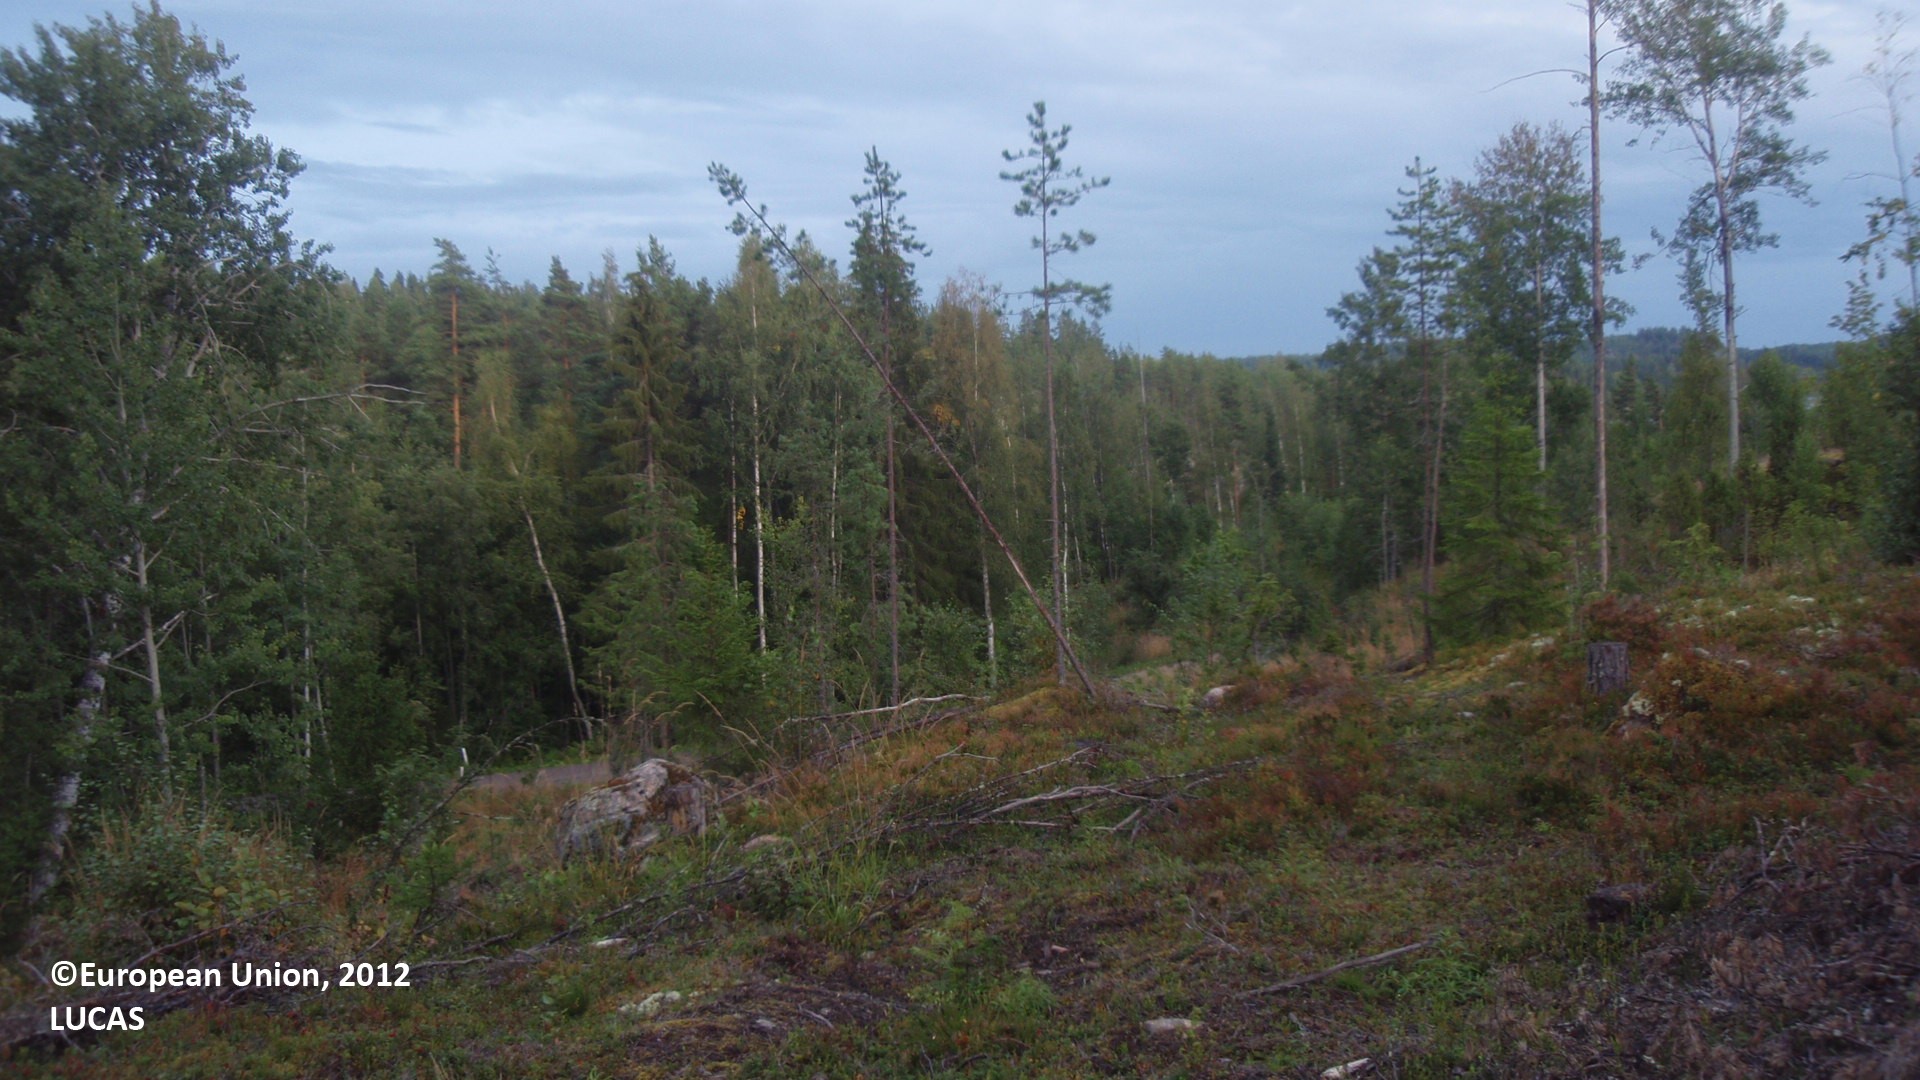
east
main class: Shrubland
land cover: Shrubland with sparse tree cover
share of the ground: > 75 %
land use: Forestry
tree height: > 5 m
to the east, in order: Shrubland with sparse tree cover; Broadleaved woodland; Ditches and canals; Paved roads, cycling and walking lanes; Grass margins; Ditches and canals; Spruce dominated mixed woodland; Inland marshes
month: August
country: FI
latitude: 61.5880
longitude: 27.8410
